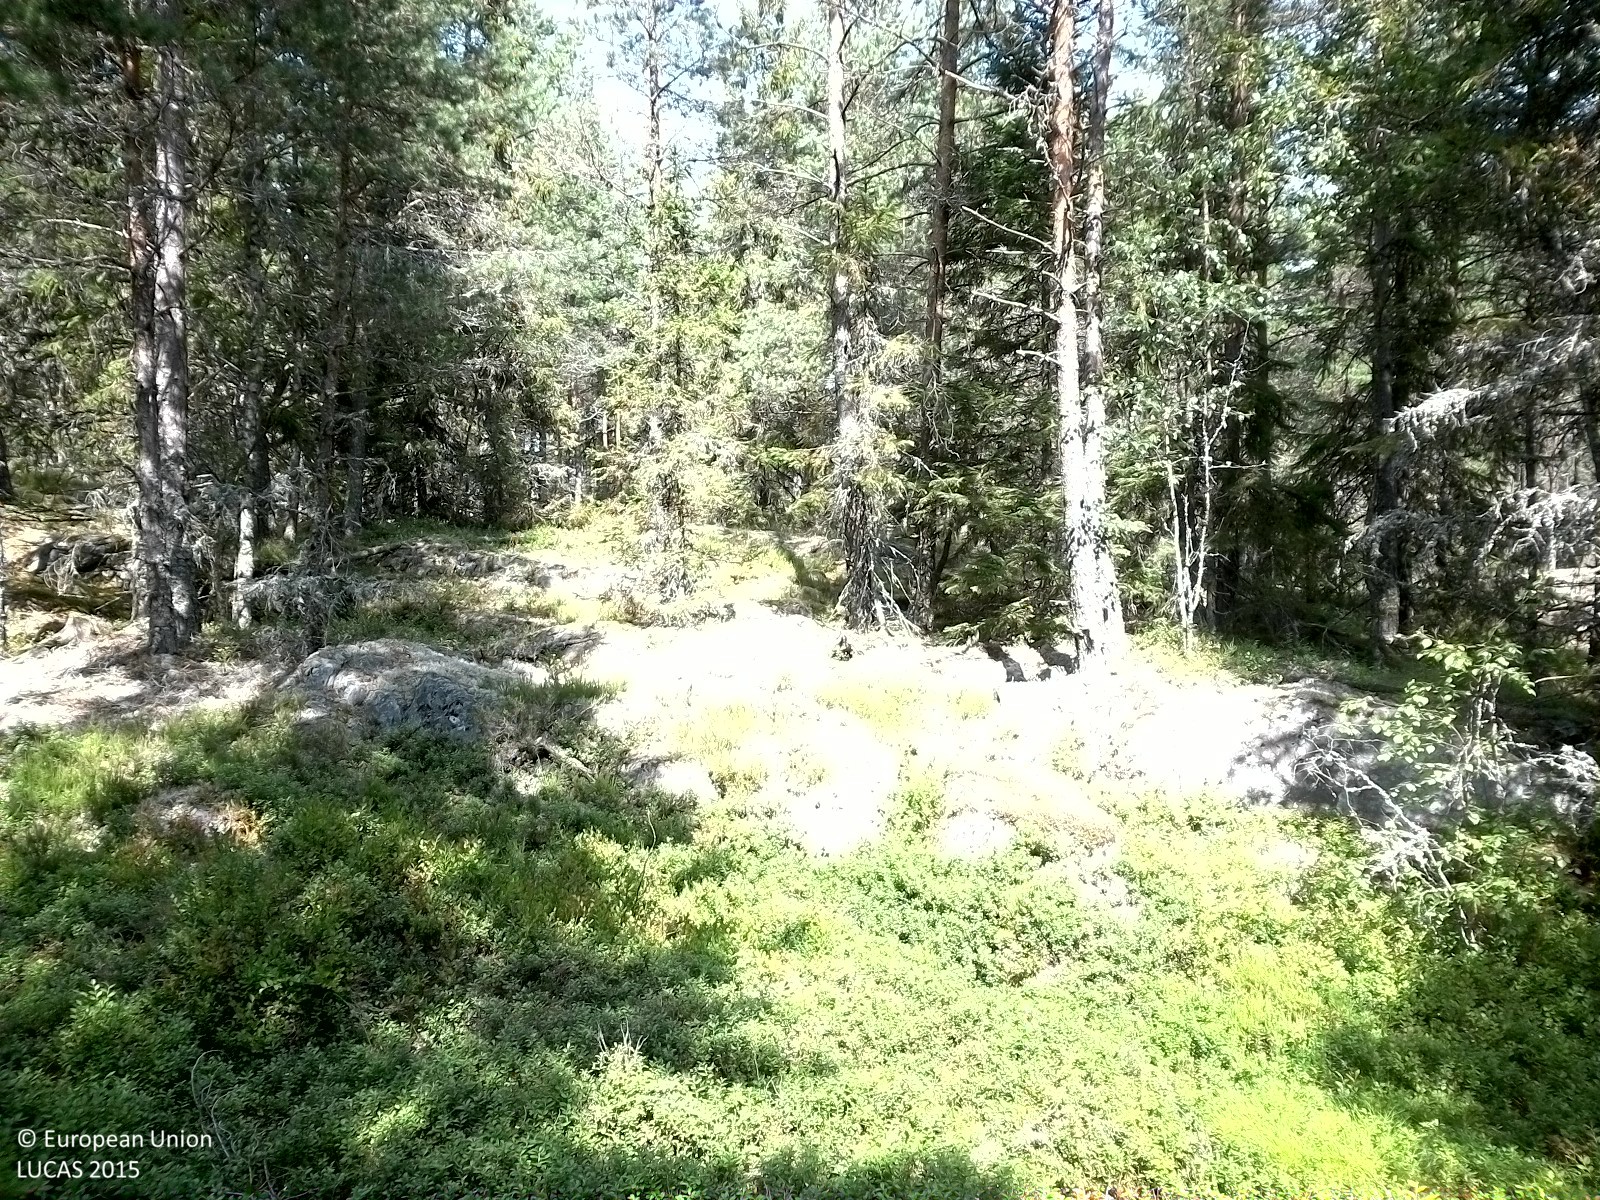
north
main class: Woodland
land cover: Pine dominated coniferous woodland
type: boreal forest
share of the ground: 25 - 50 %
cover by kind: shrubs 50 %, coniferous forest trees 30 %, broadleaved forest trees 10 %, herbaceous plants 10 %
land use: Forestry
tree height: > 5 m
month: August
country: SE
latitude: 58.9049
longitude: 15.3917
